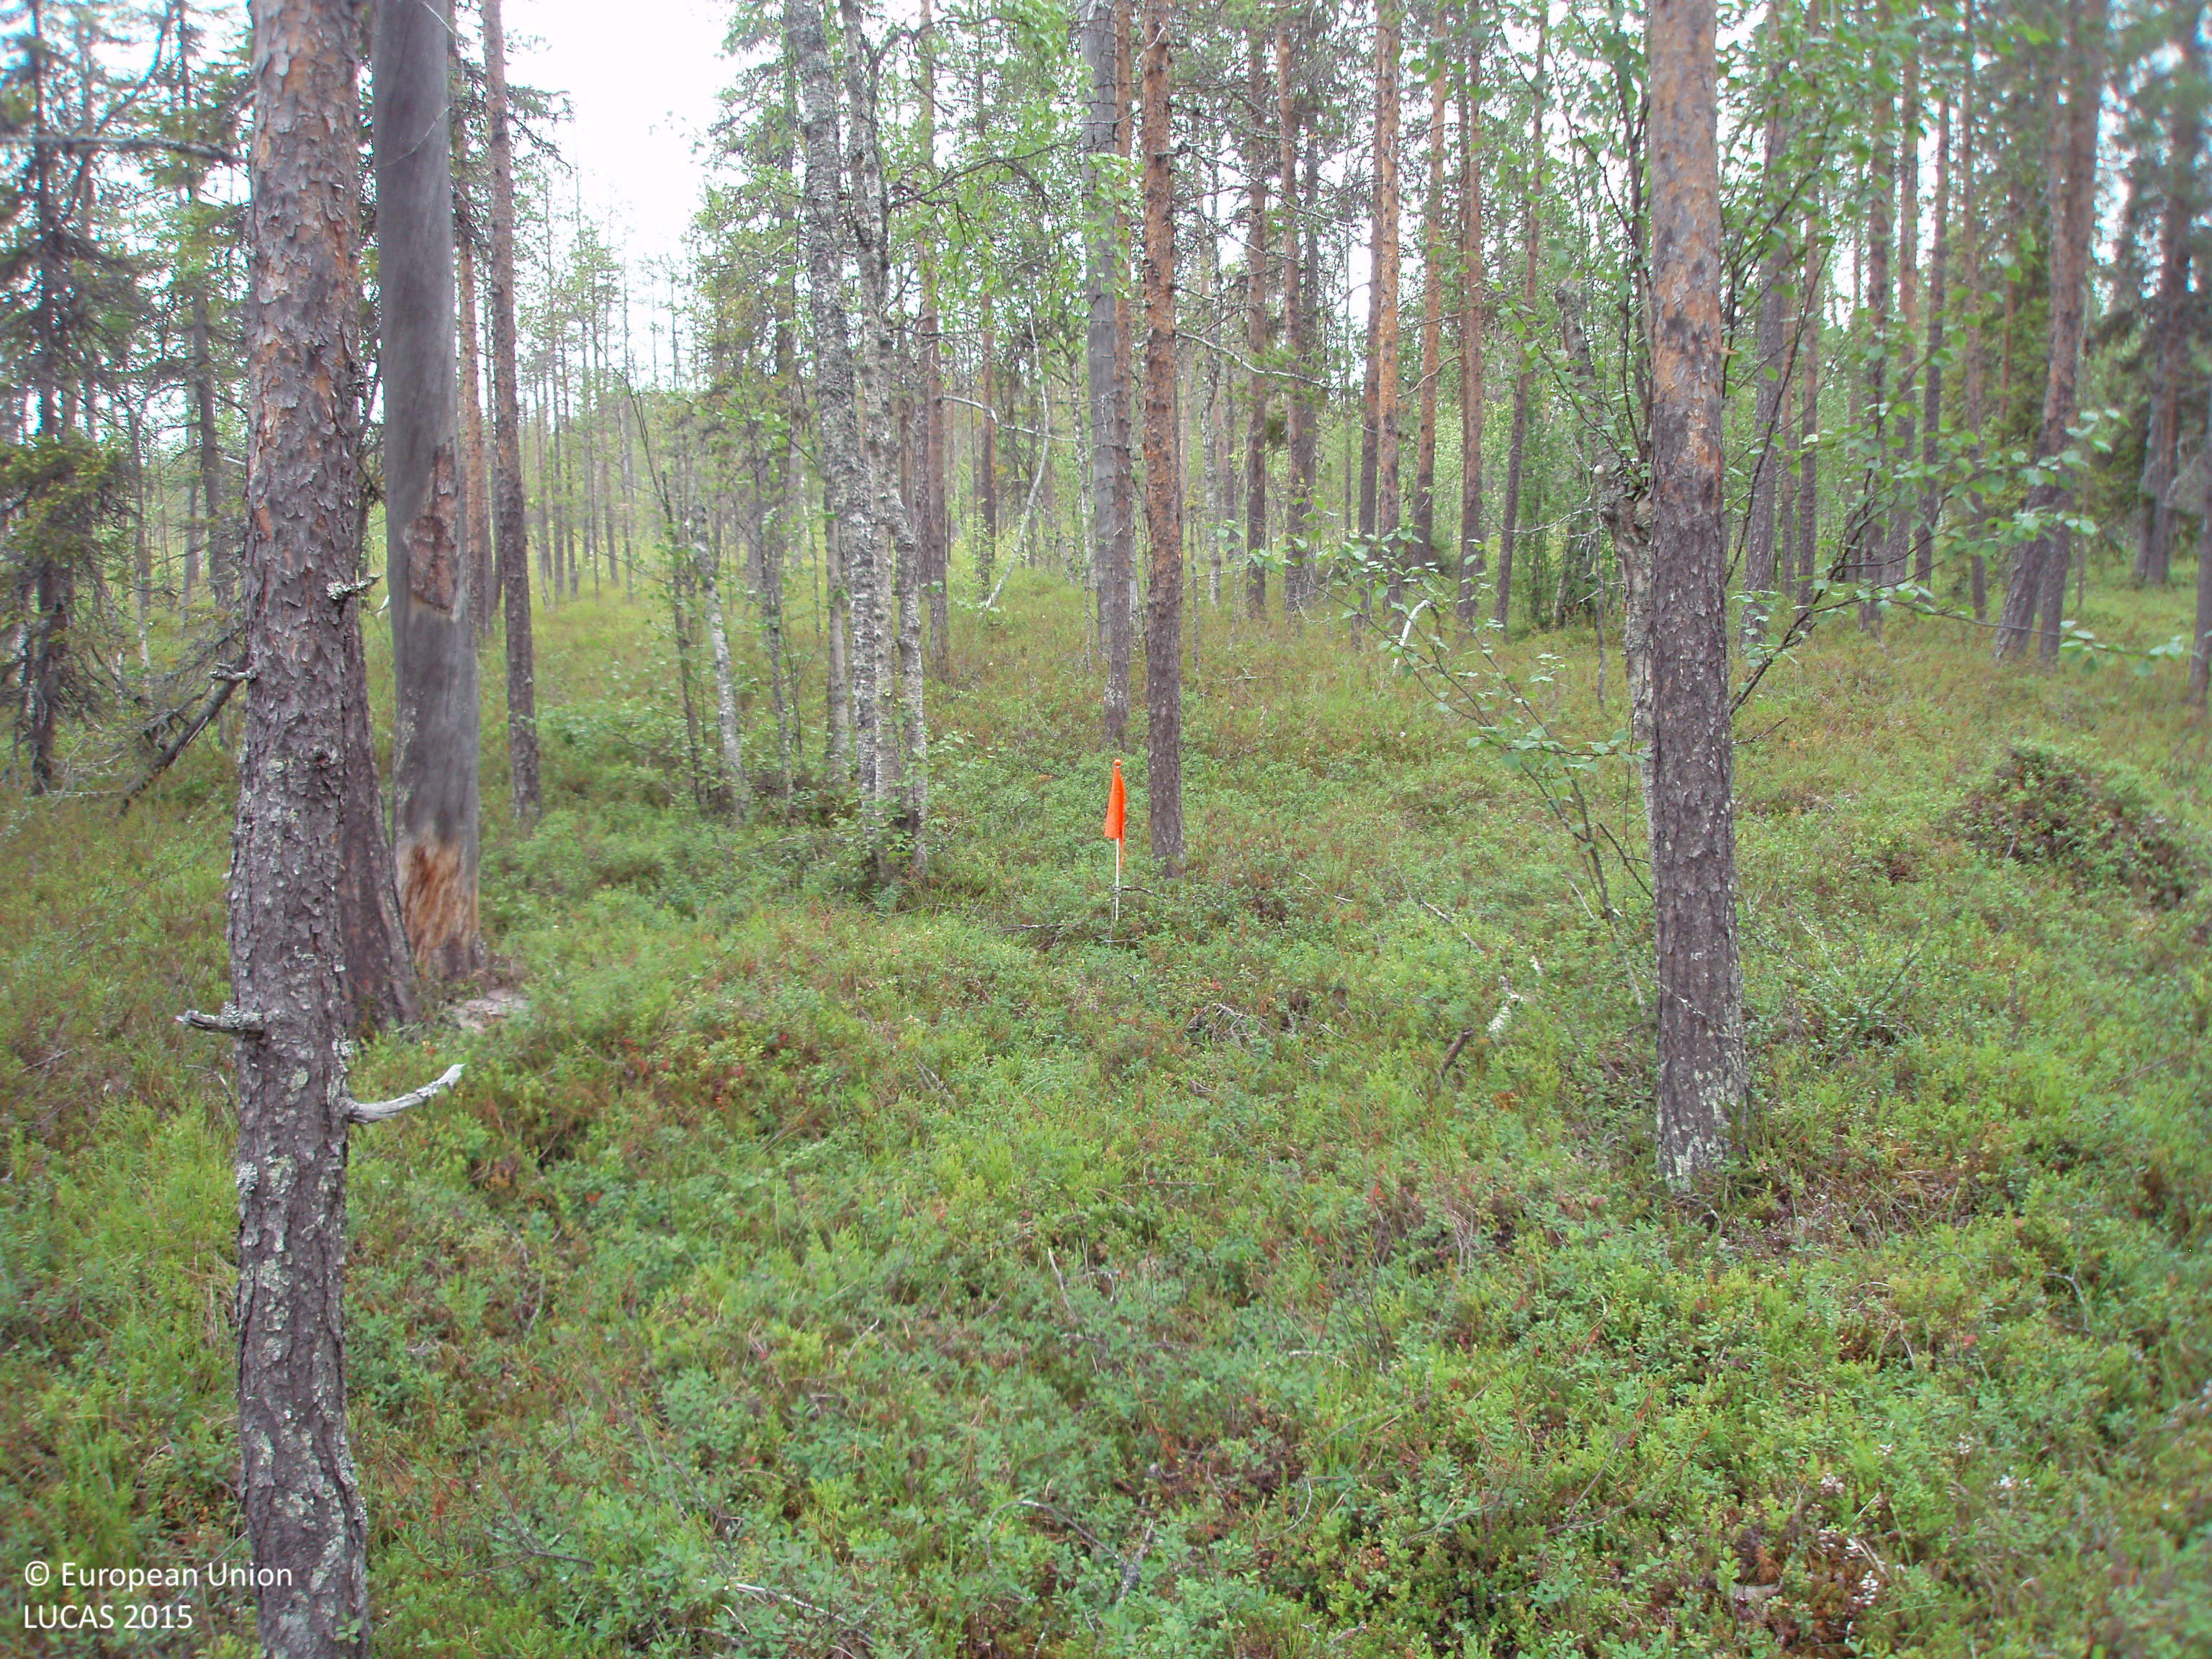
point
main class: Woodland
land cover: Pine dominated mixed woodland
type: boreal forest
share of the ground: 50 - 75 %
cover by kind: shrubs 40 %, coniferous forest trees 35 %, broadleaved forest trees 15 %, herbaceous plants 5 %, lichens and mosses 5 %
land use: Forestry
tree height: > 5 m
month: July
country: FI
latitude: 67.1871
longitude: 27.7926
